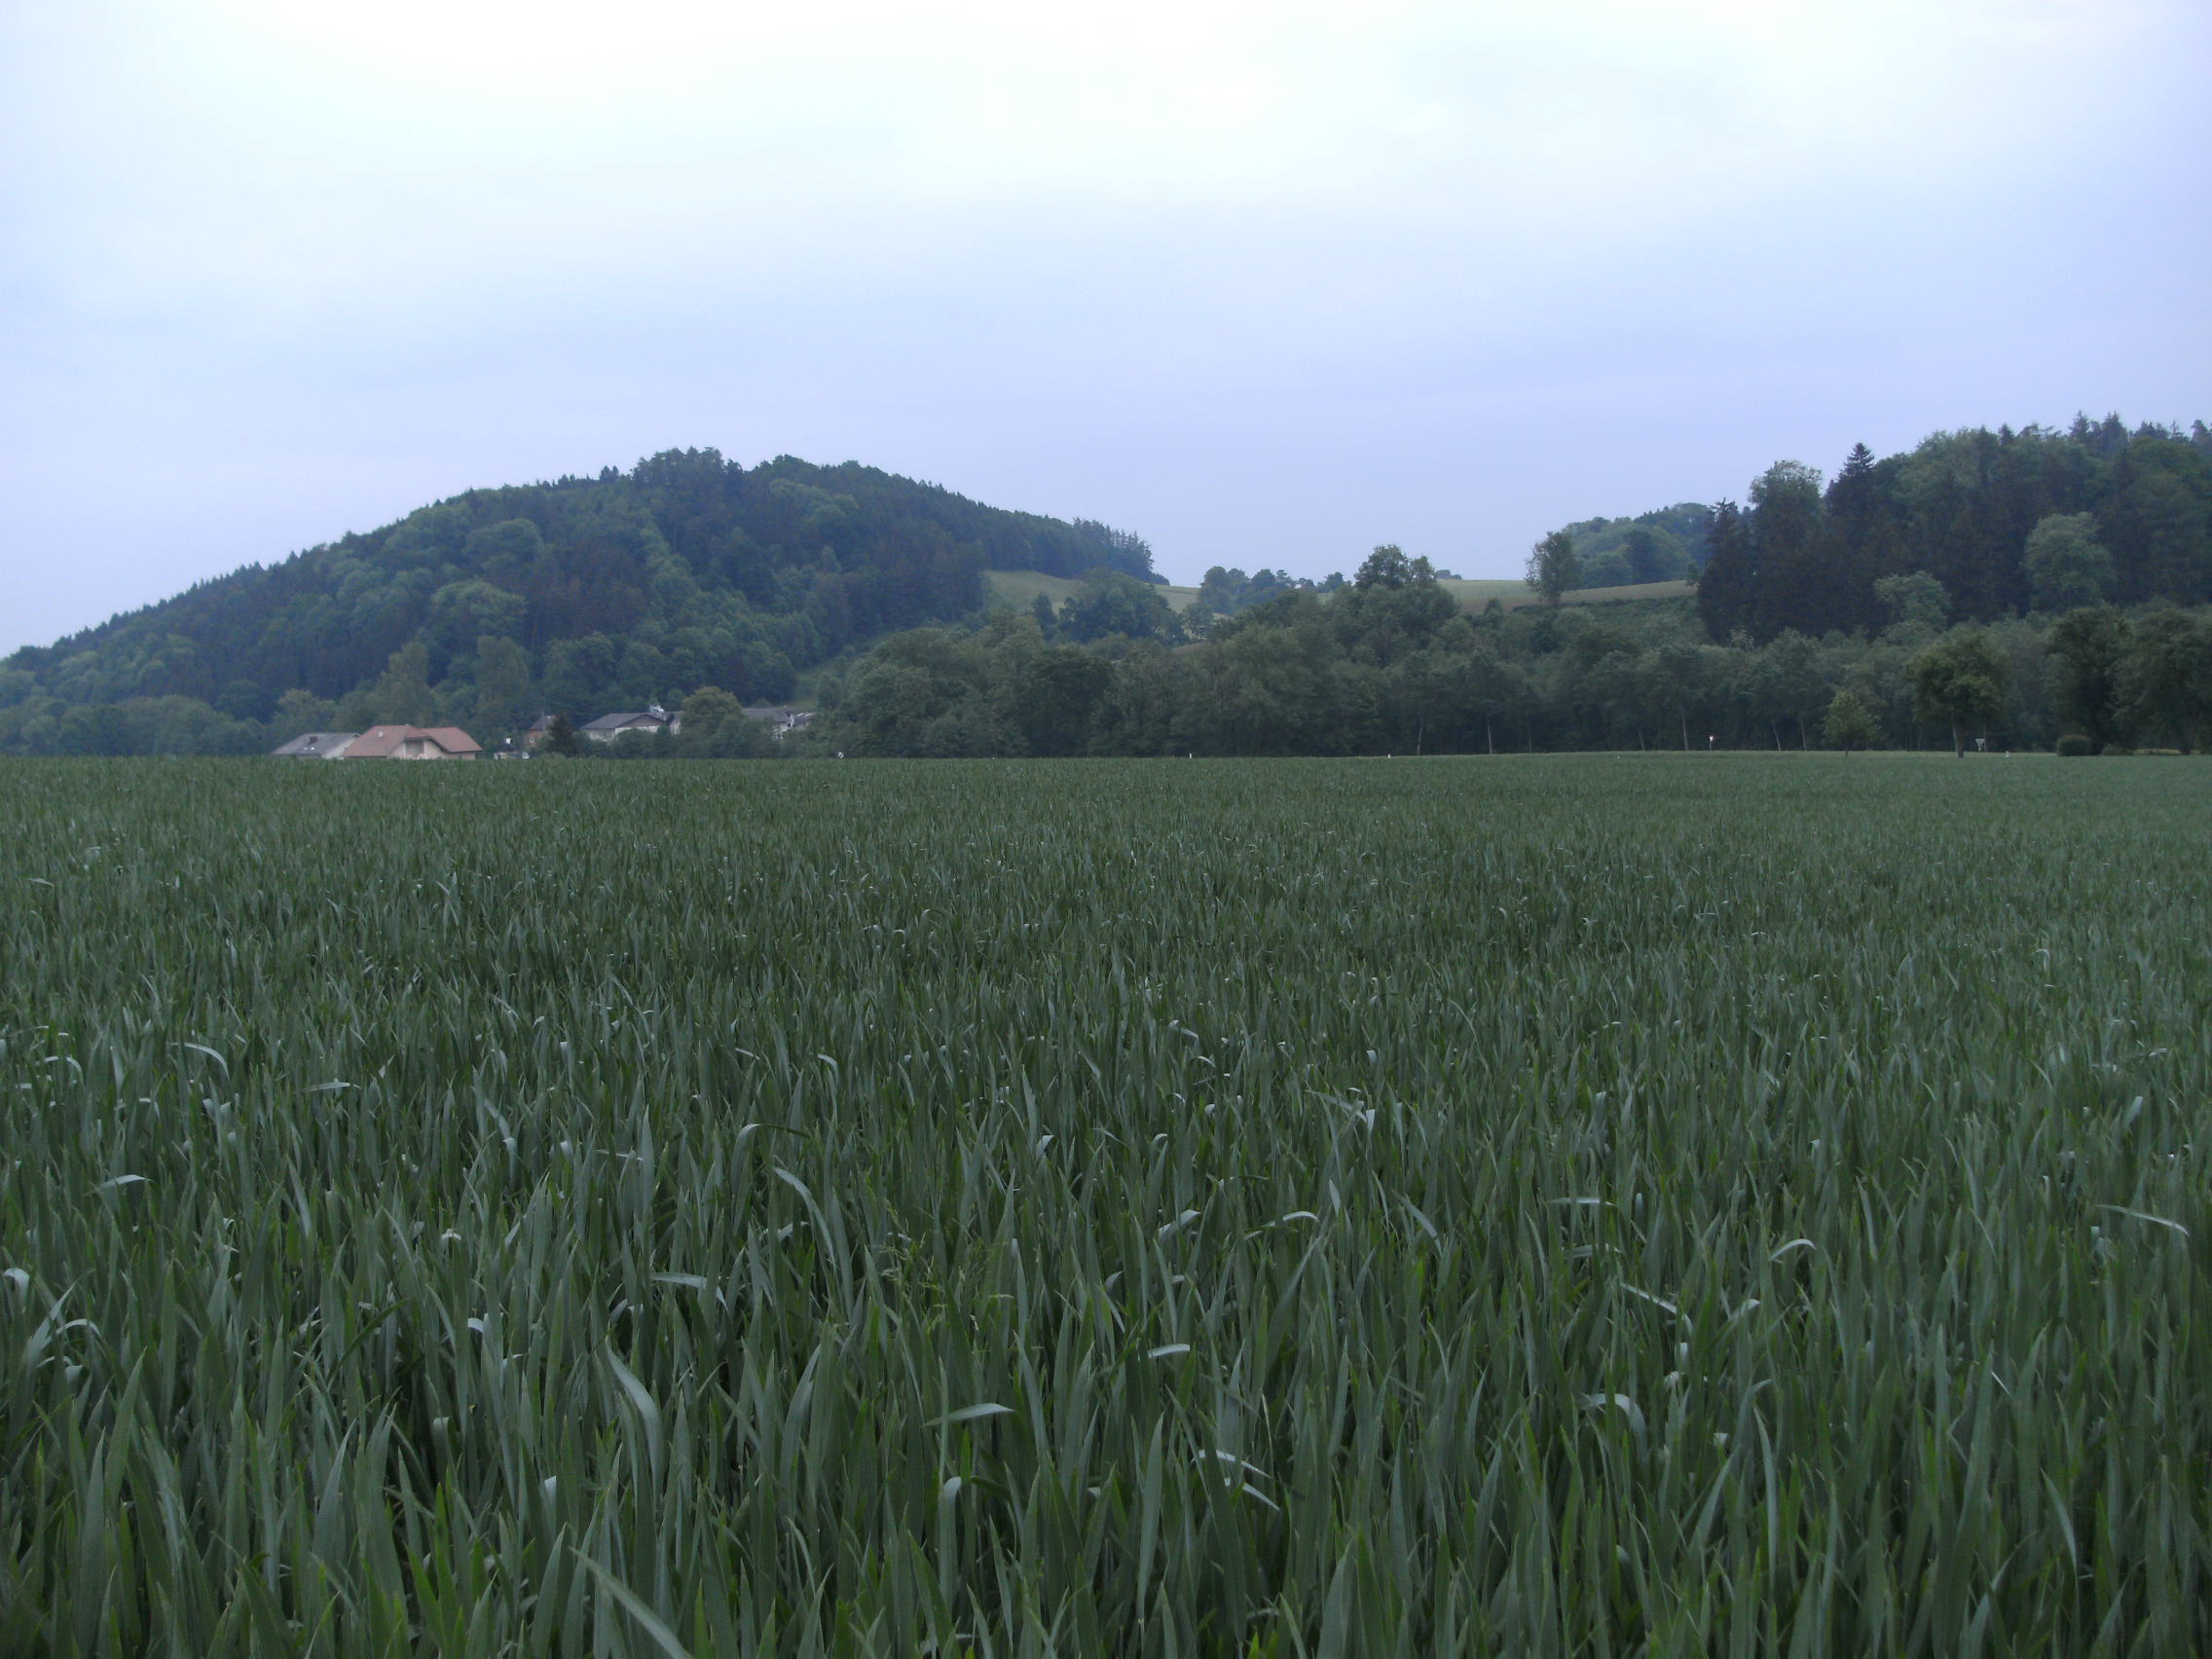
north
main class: Cropland
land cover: Common wheat
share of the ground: > 75 %
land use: Agriculture (excluding fallow land and kitchen gardens)
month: May
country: AT
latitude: 48.1400
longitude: 13.8026
